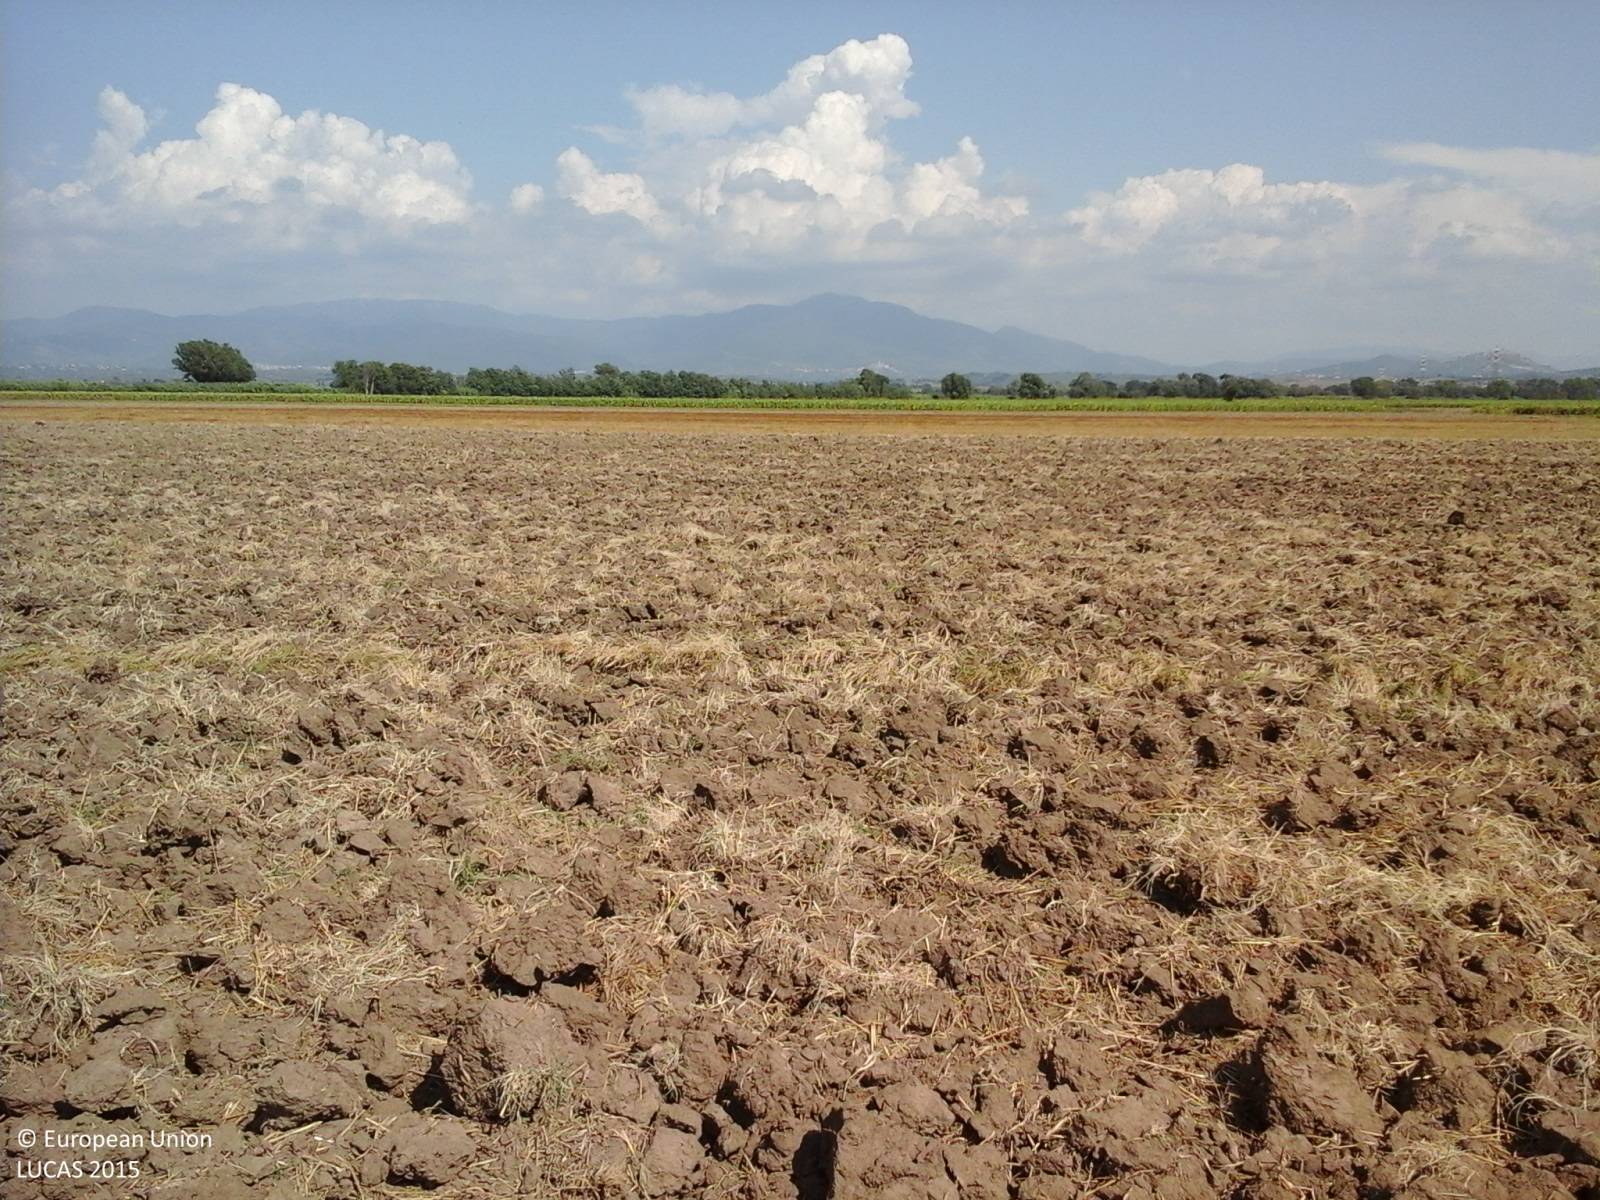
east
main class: Cropland
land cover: Durum wheat
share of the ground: < 10 %
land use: Agriculture (excluding fallow land and kitchen gardens)
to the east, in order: Durum wheat; Ditches and canals; Durum wheat; Electric lines; Durum wheat
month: July
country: IT
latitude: 42.1148
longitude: 12.5911
